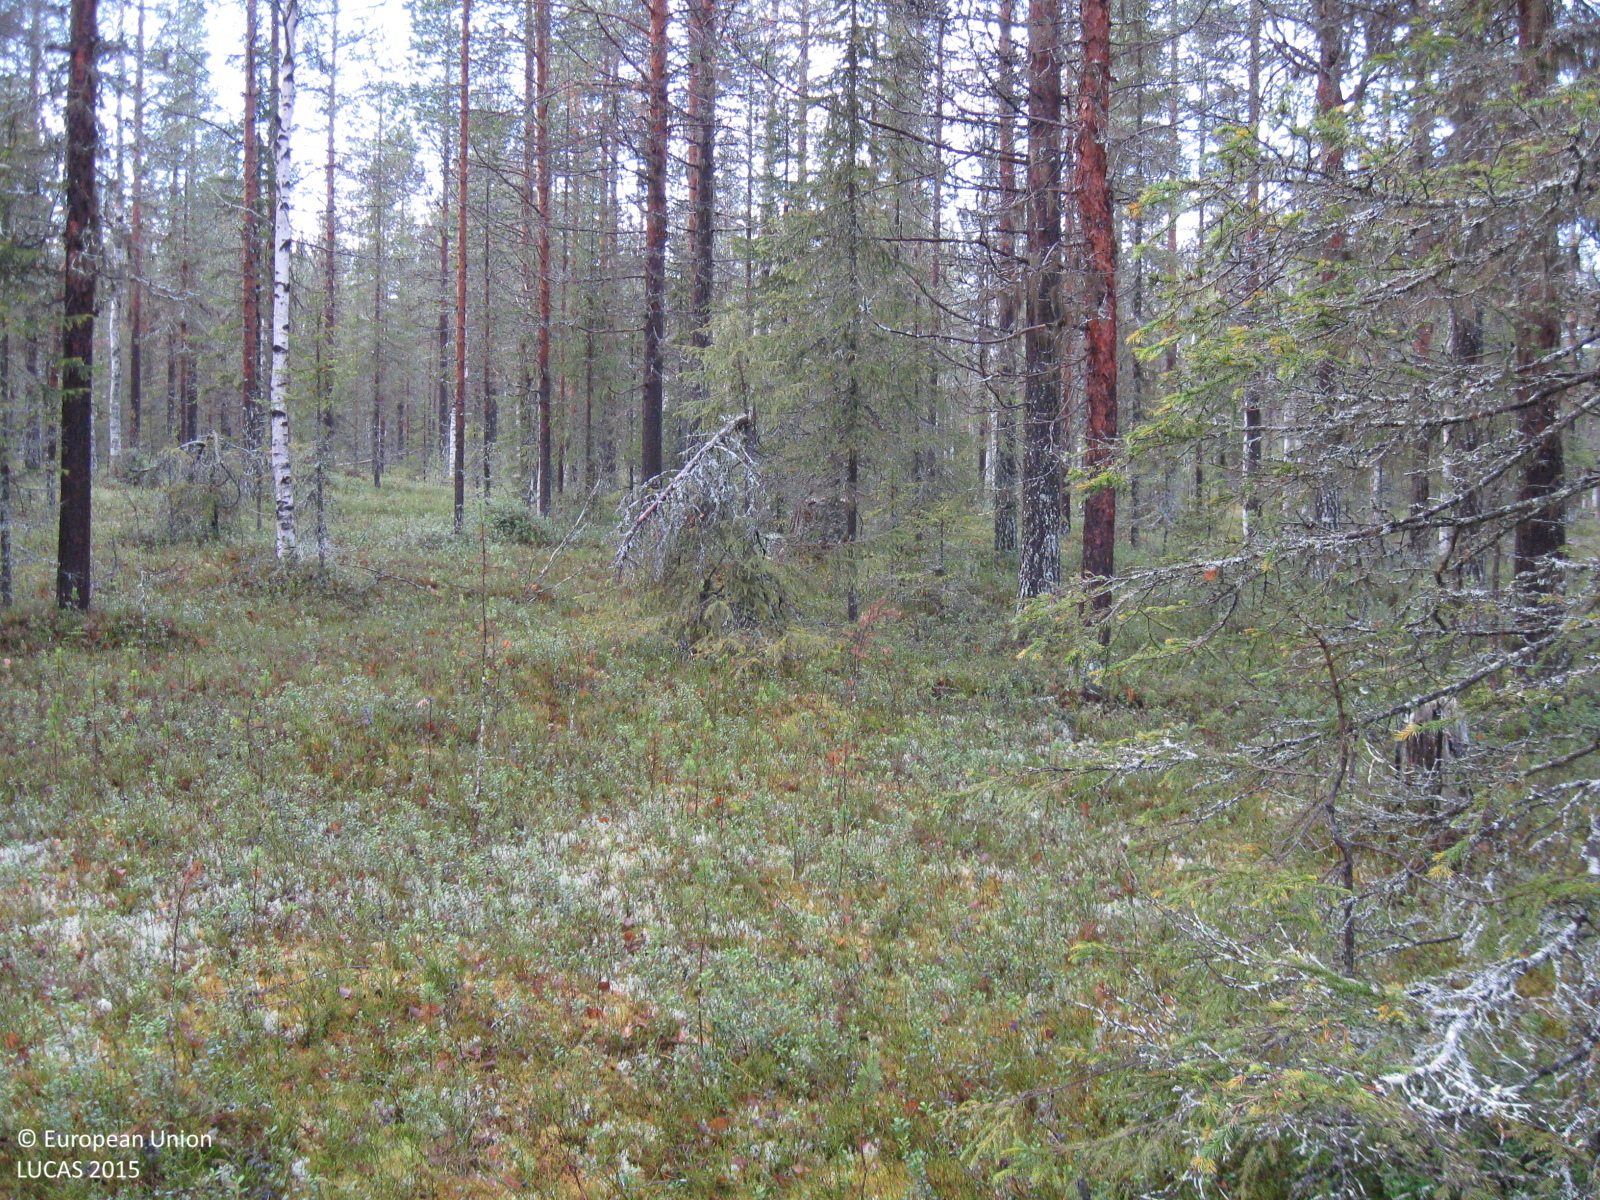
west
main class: Woodland
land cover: Pine dominated coniferous woodland
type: boreal forest
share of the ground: 50 - 75 %
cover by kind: coniferous forest trees 60 %, broadleaved forest trees 15 %, shrubs 10 %, lichens and mosses 10 %, herbaceous plants 5 %
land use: Forestry
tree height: > 5 m
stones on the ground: > 50 %
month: October
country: SE
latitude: 66.5082
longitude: 20.9068
